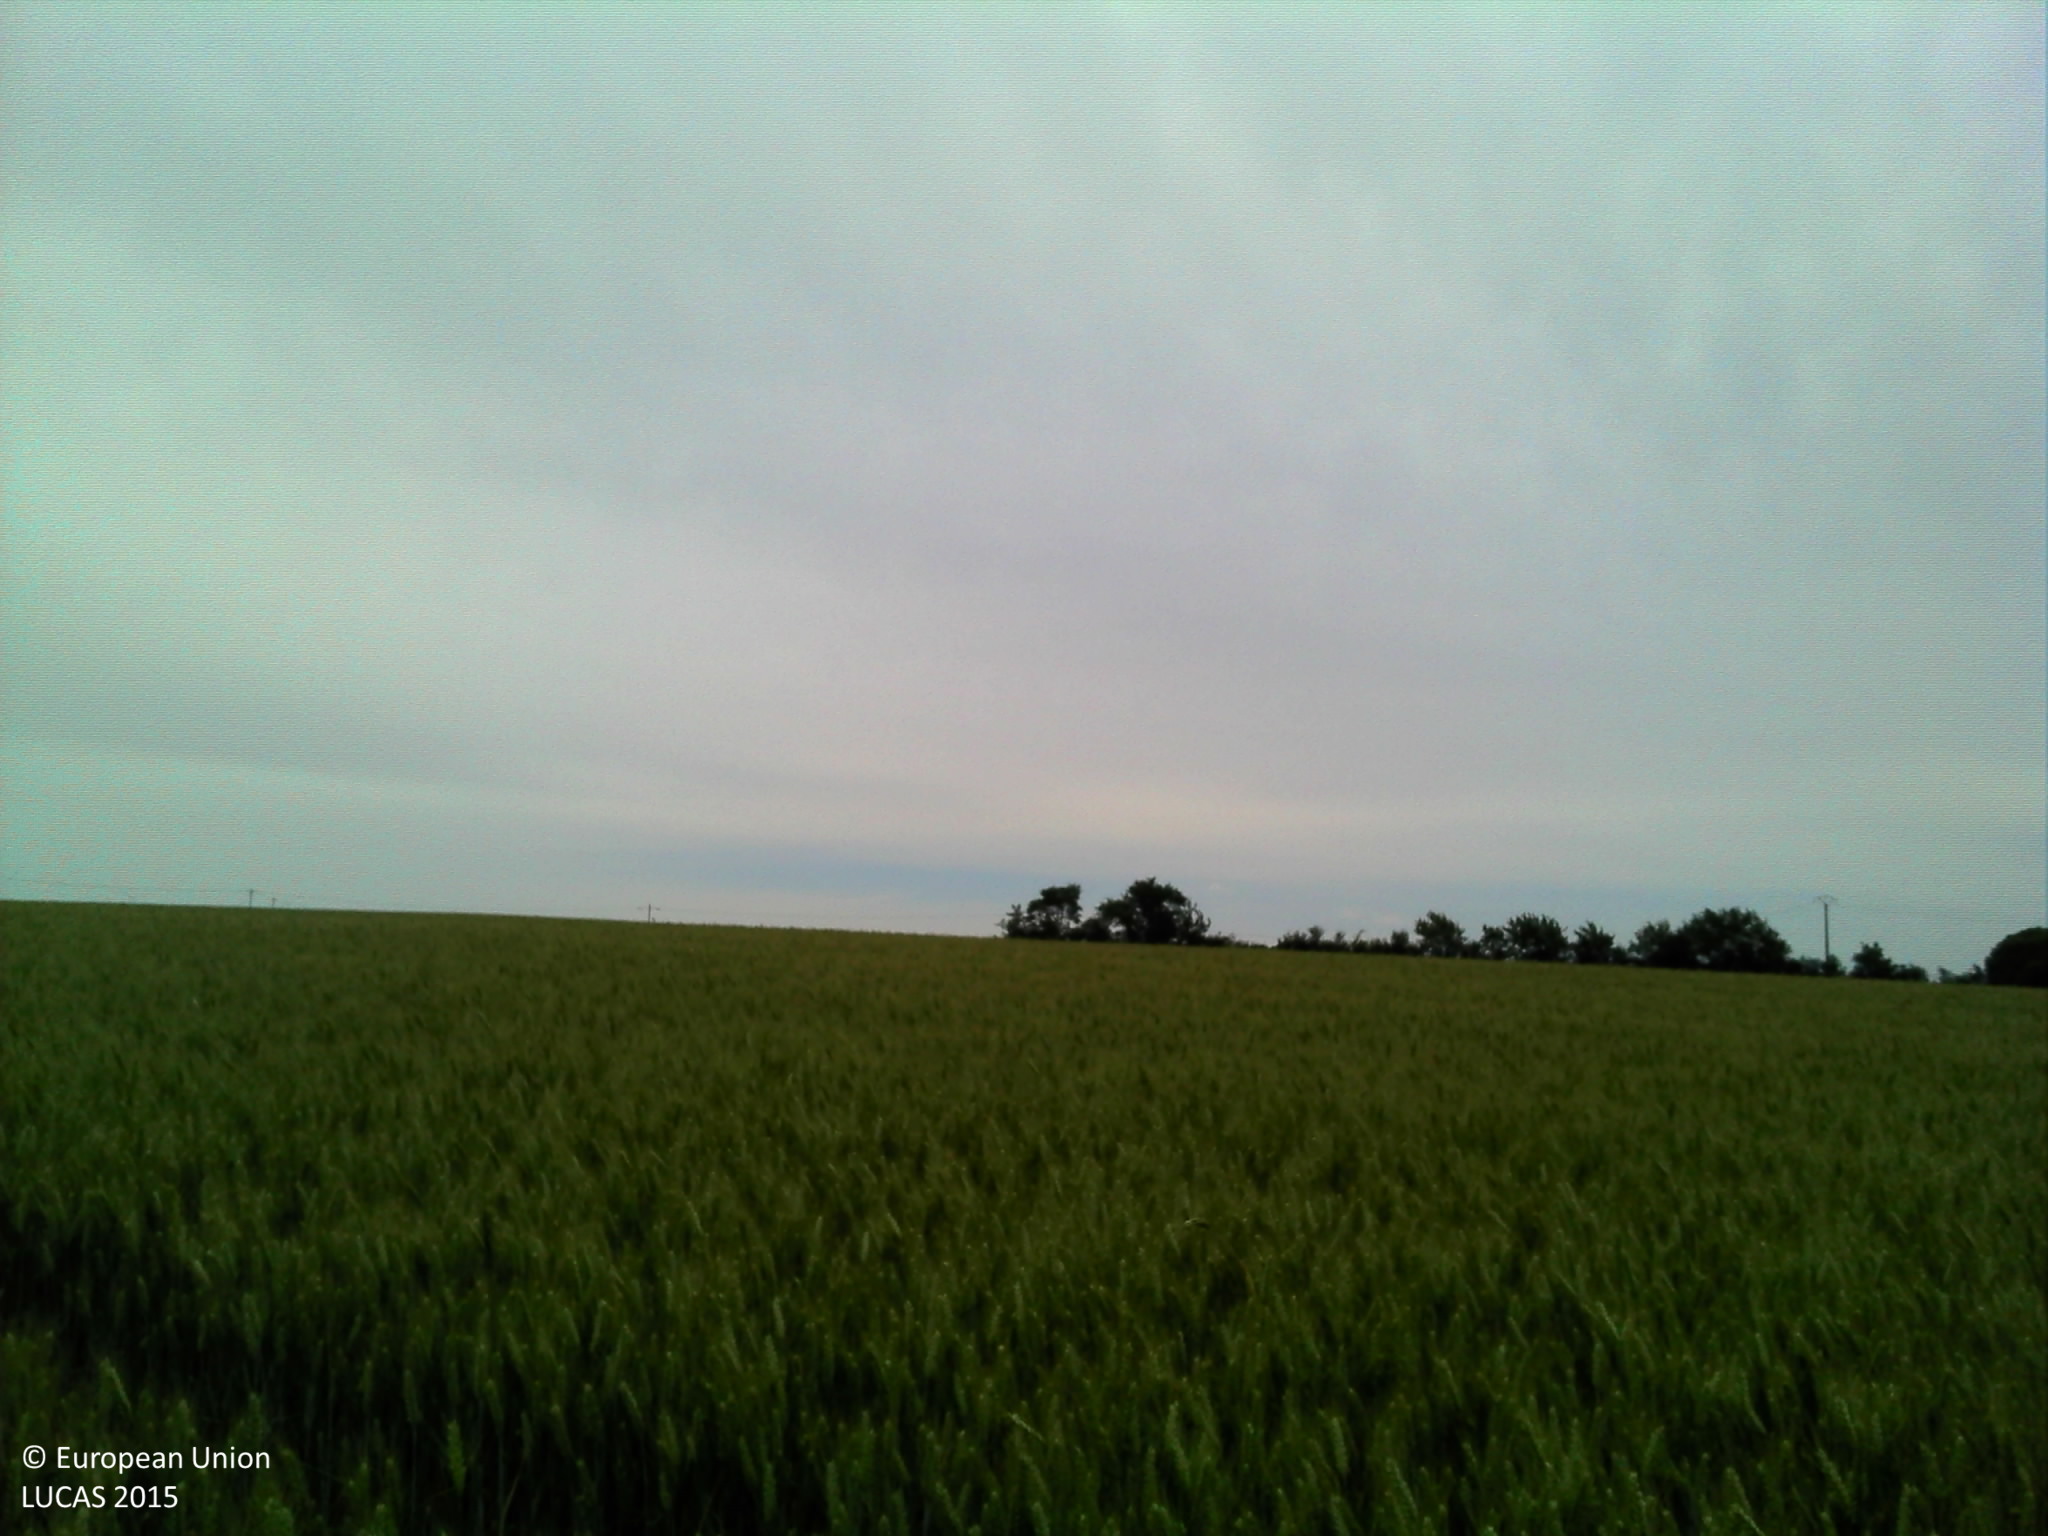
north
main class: Cropland
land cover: Triticale
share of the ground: > 75 %
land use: Agriculture (excluding fallow land and kitchen gardens)
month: June
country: FR
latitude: 48.2871
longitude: -0.0703
